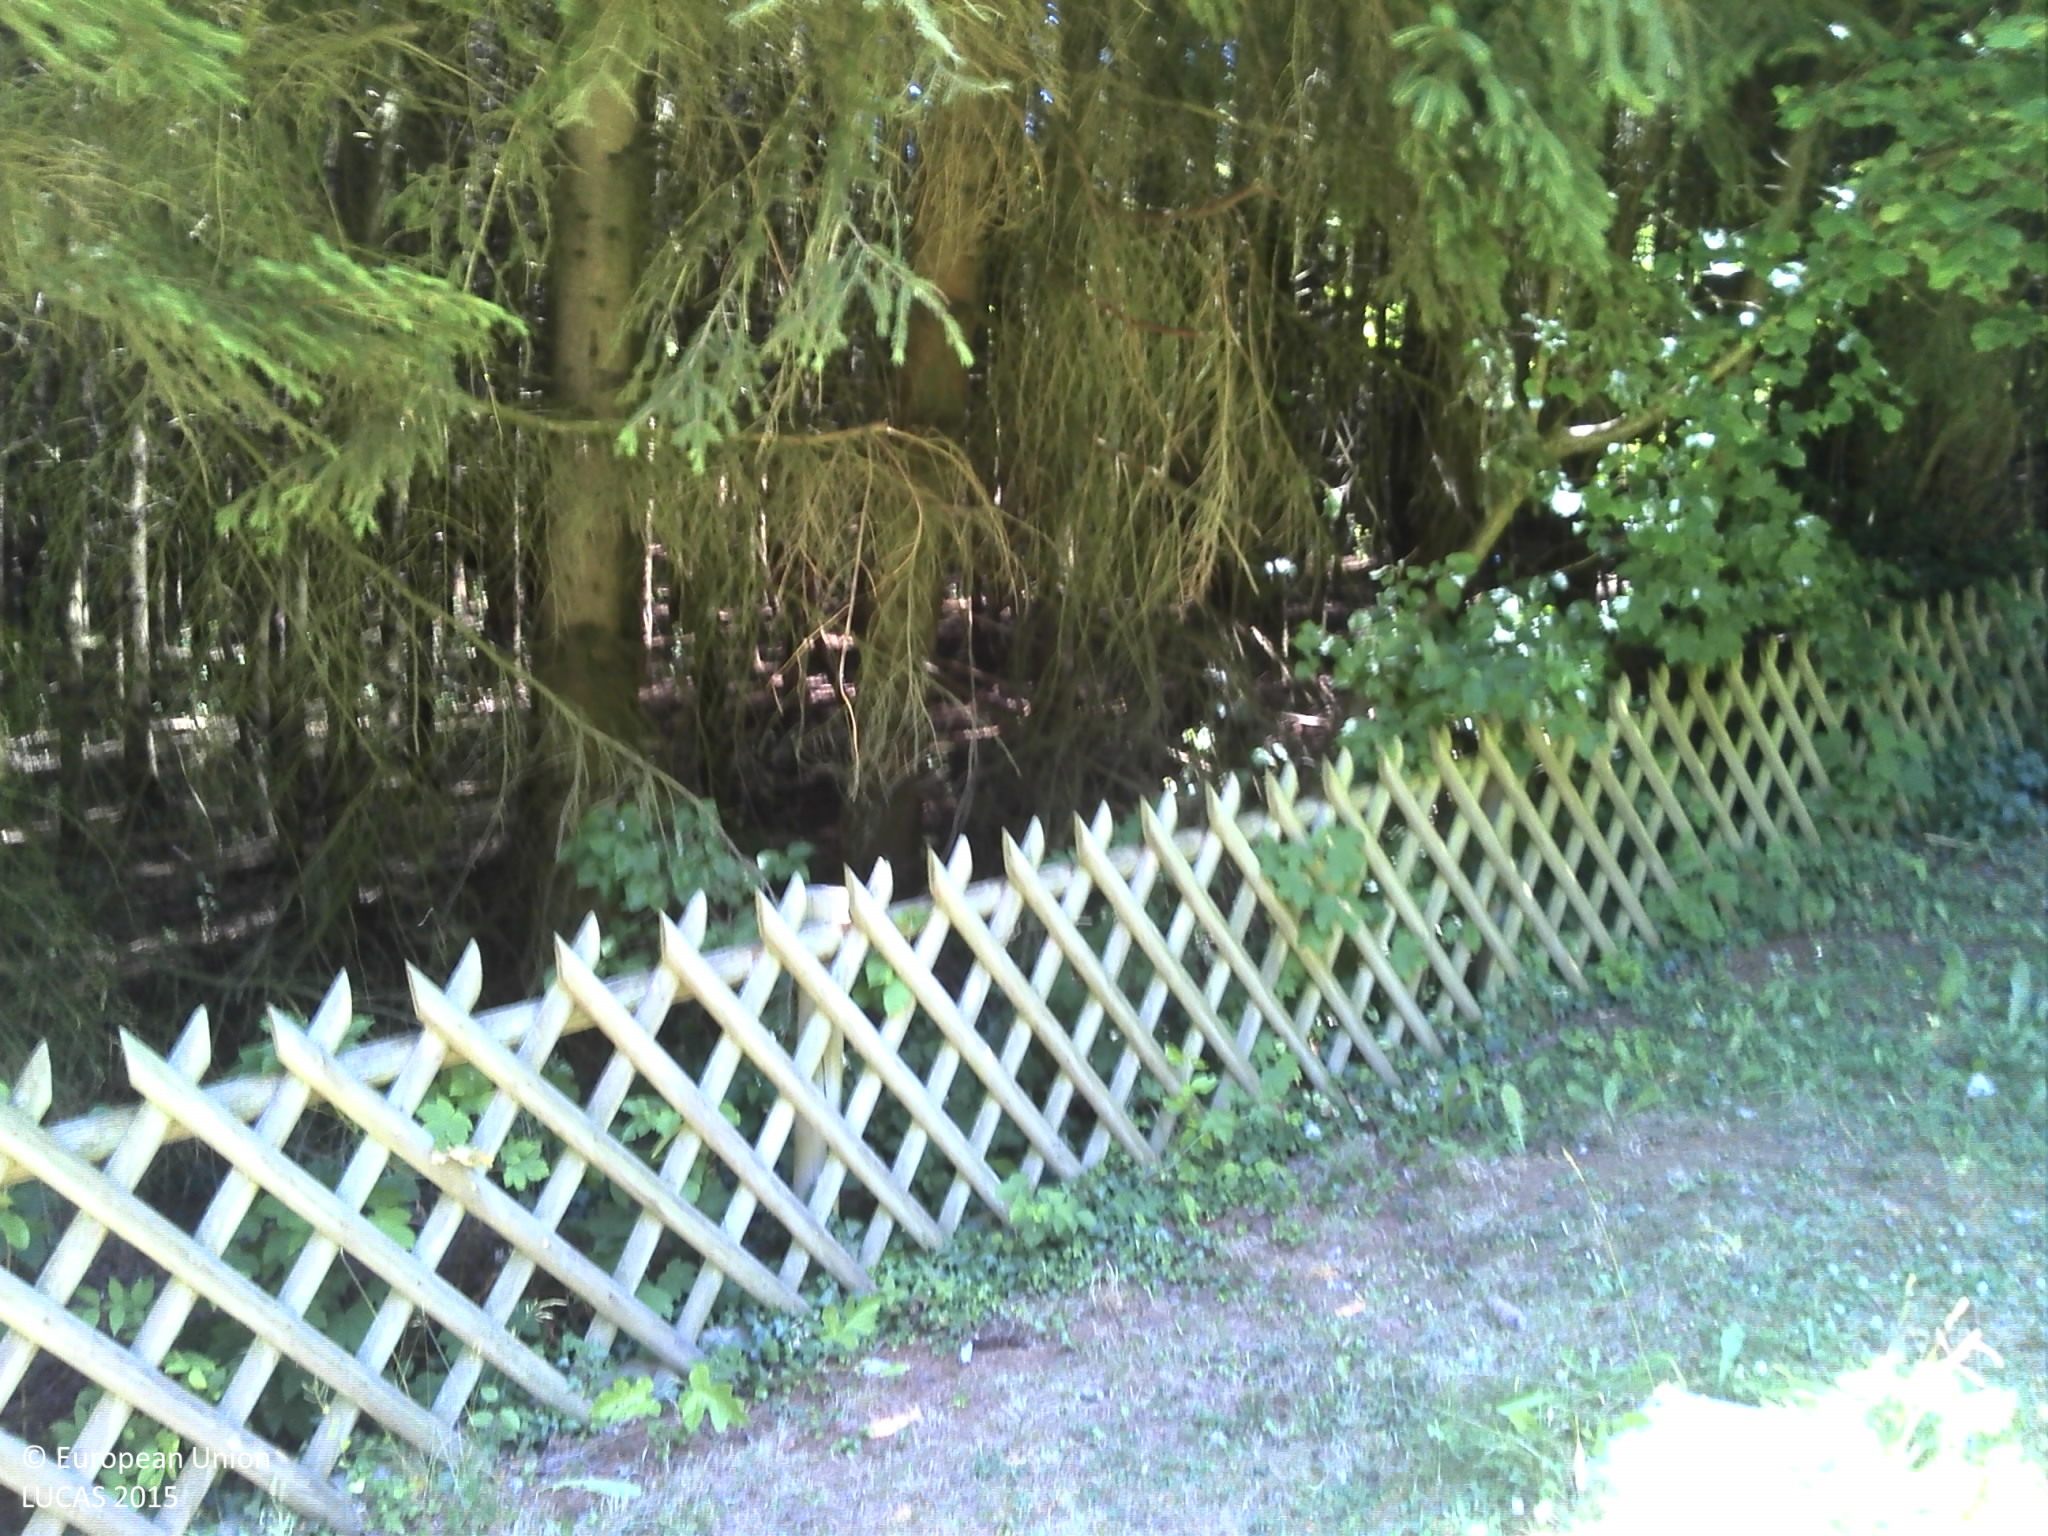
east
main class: Grassland
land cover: Grassland without tree/shrub cover
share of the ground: > 75 %
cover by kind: herbaceous plants 100 %
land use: Residential
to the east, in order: Grassland without tree/shrub cover; Fences; Spruce dominated coniferous woodland; Broadleaved woodland
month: June
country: FR
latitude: 49.3785
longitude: 6.0739
